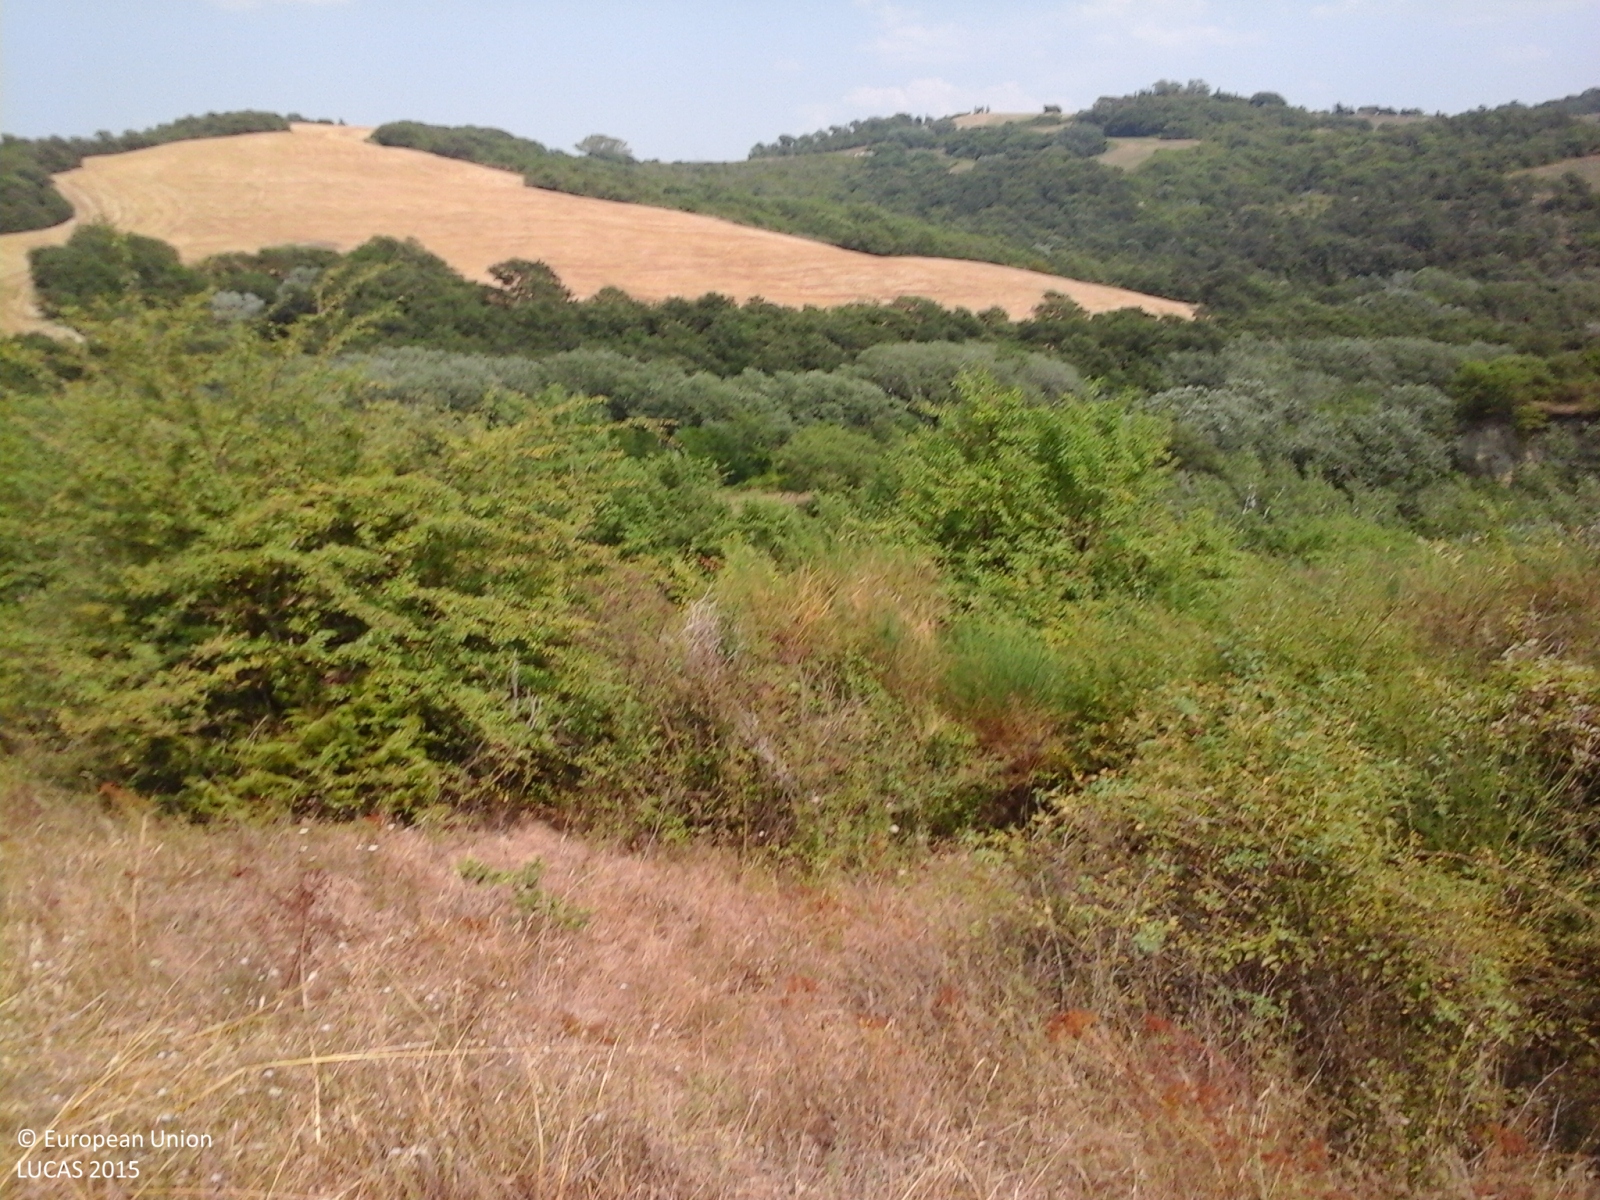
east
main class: Woodland
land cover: Broadleaved woodland
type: thermophilous deciduous forest
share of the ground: > 75 %
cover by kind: broadleaved forest trees 75 %, shrubs 20 %, herbaceous plants 5 %
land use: Semi-natural and natural areas not in use
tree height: > 5 m
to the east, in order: Broadleaved woodland; Lucerne; Broadleaved woodland
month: July
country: IT
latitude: 43.1297
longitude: 11.5565
